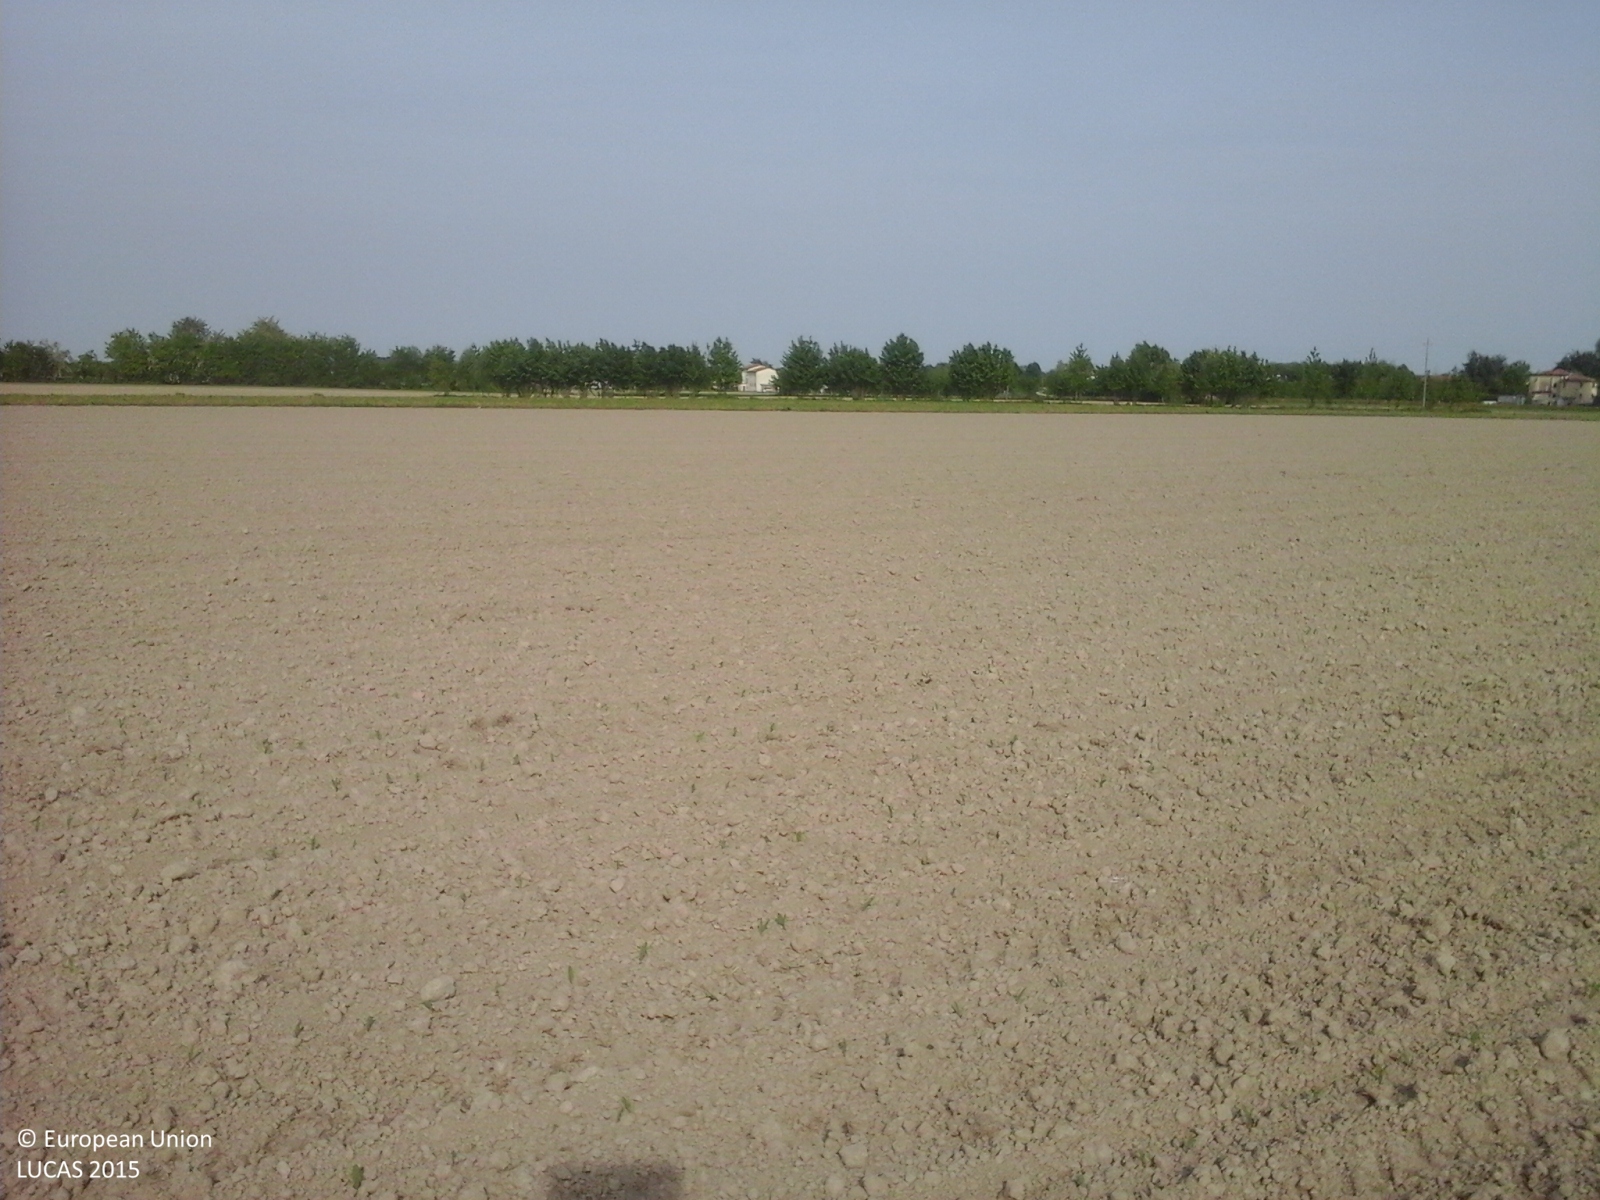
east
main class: Cropland
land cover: Maize
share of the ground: < 10 %
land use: Agriculture (excluding fallow land and kitchen gardens)
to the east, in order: Maize; Lucerne; Ditches and canals; Managed hedges; Ditches and canals; Soya
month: May
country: IT
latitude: 45.5251
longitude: 11.8024
